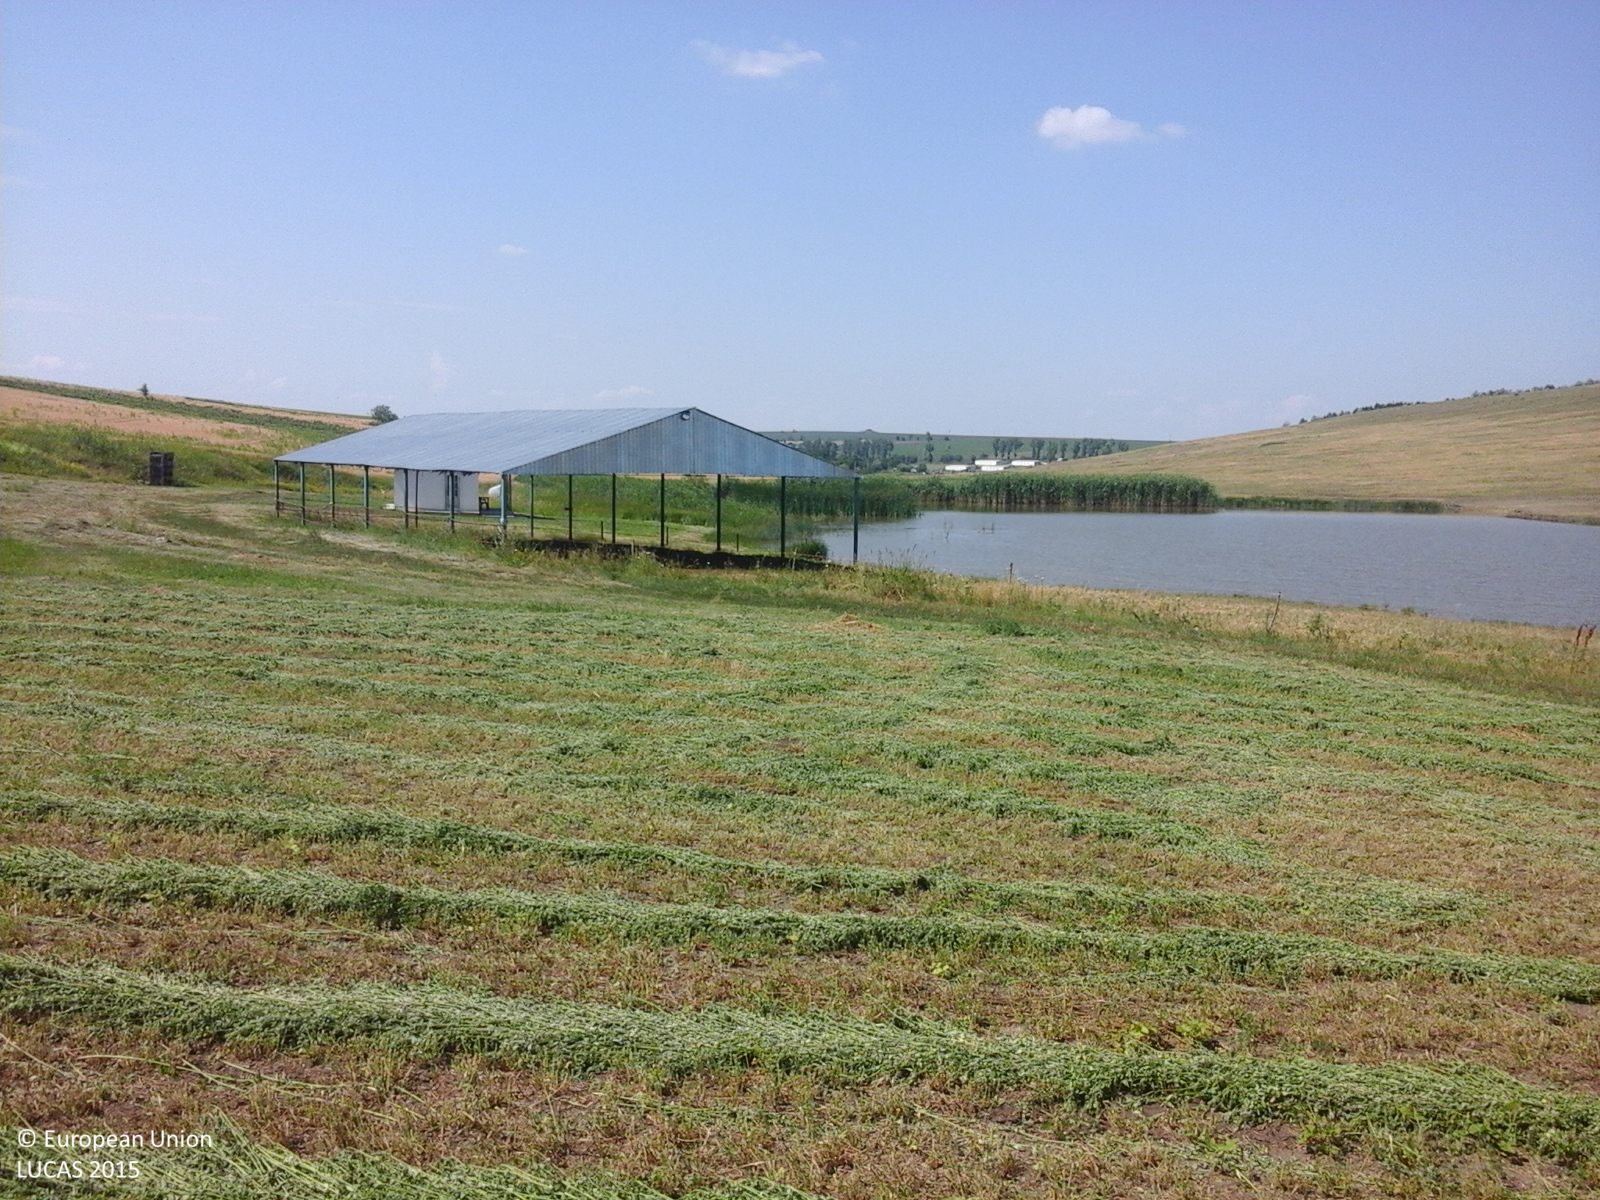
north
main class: Cropland
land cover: Lucerne
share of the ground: 10 - 25 %
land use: Agriculture (excluding fallow land and kitchen gardens)
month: June
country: RO
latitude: 47.3081
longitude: 27.3745
